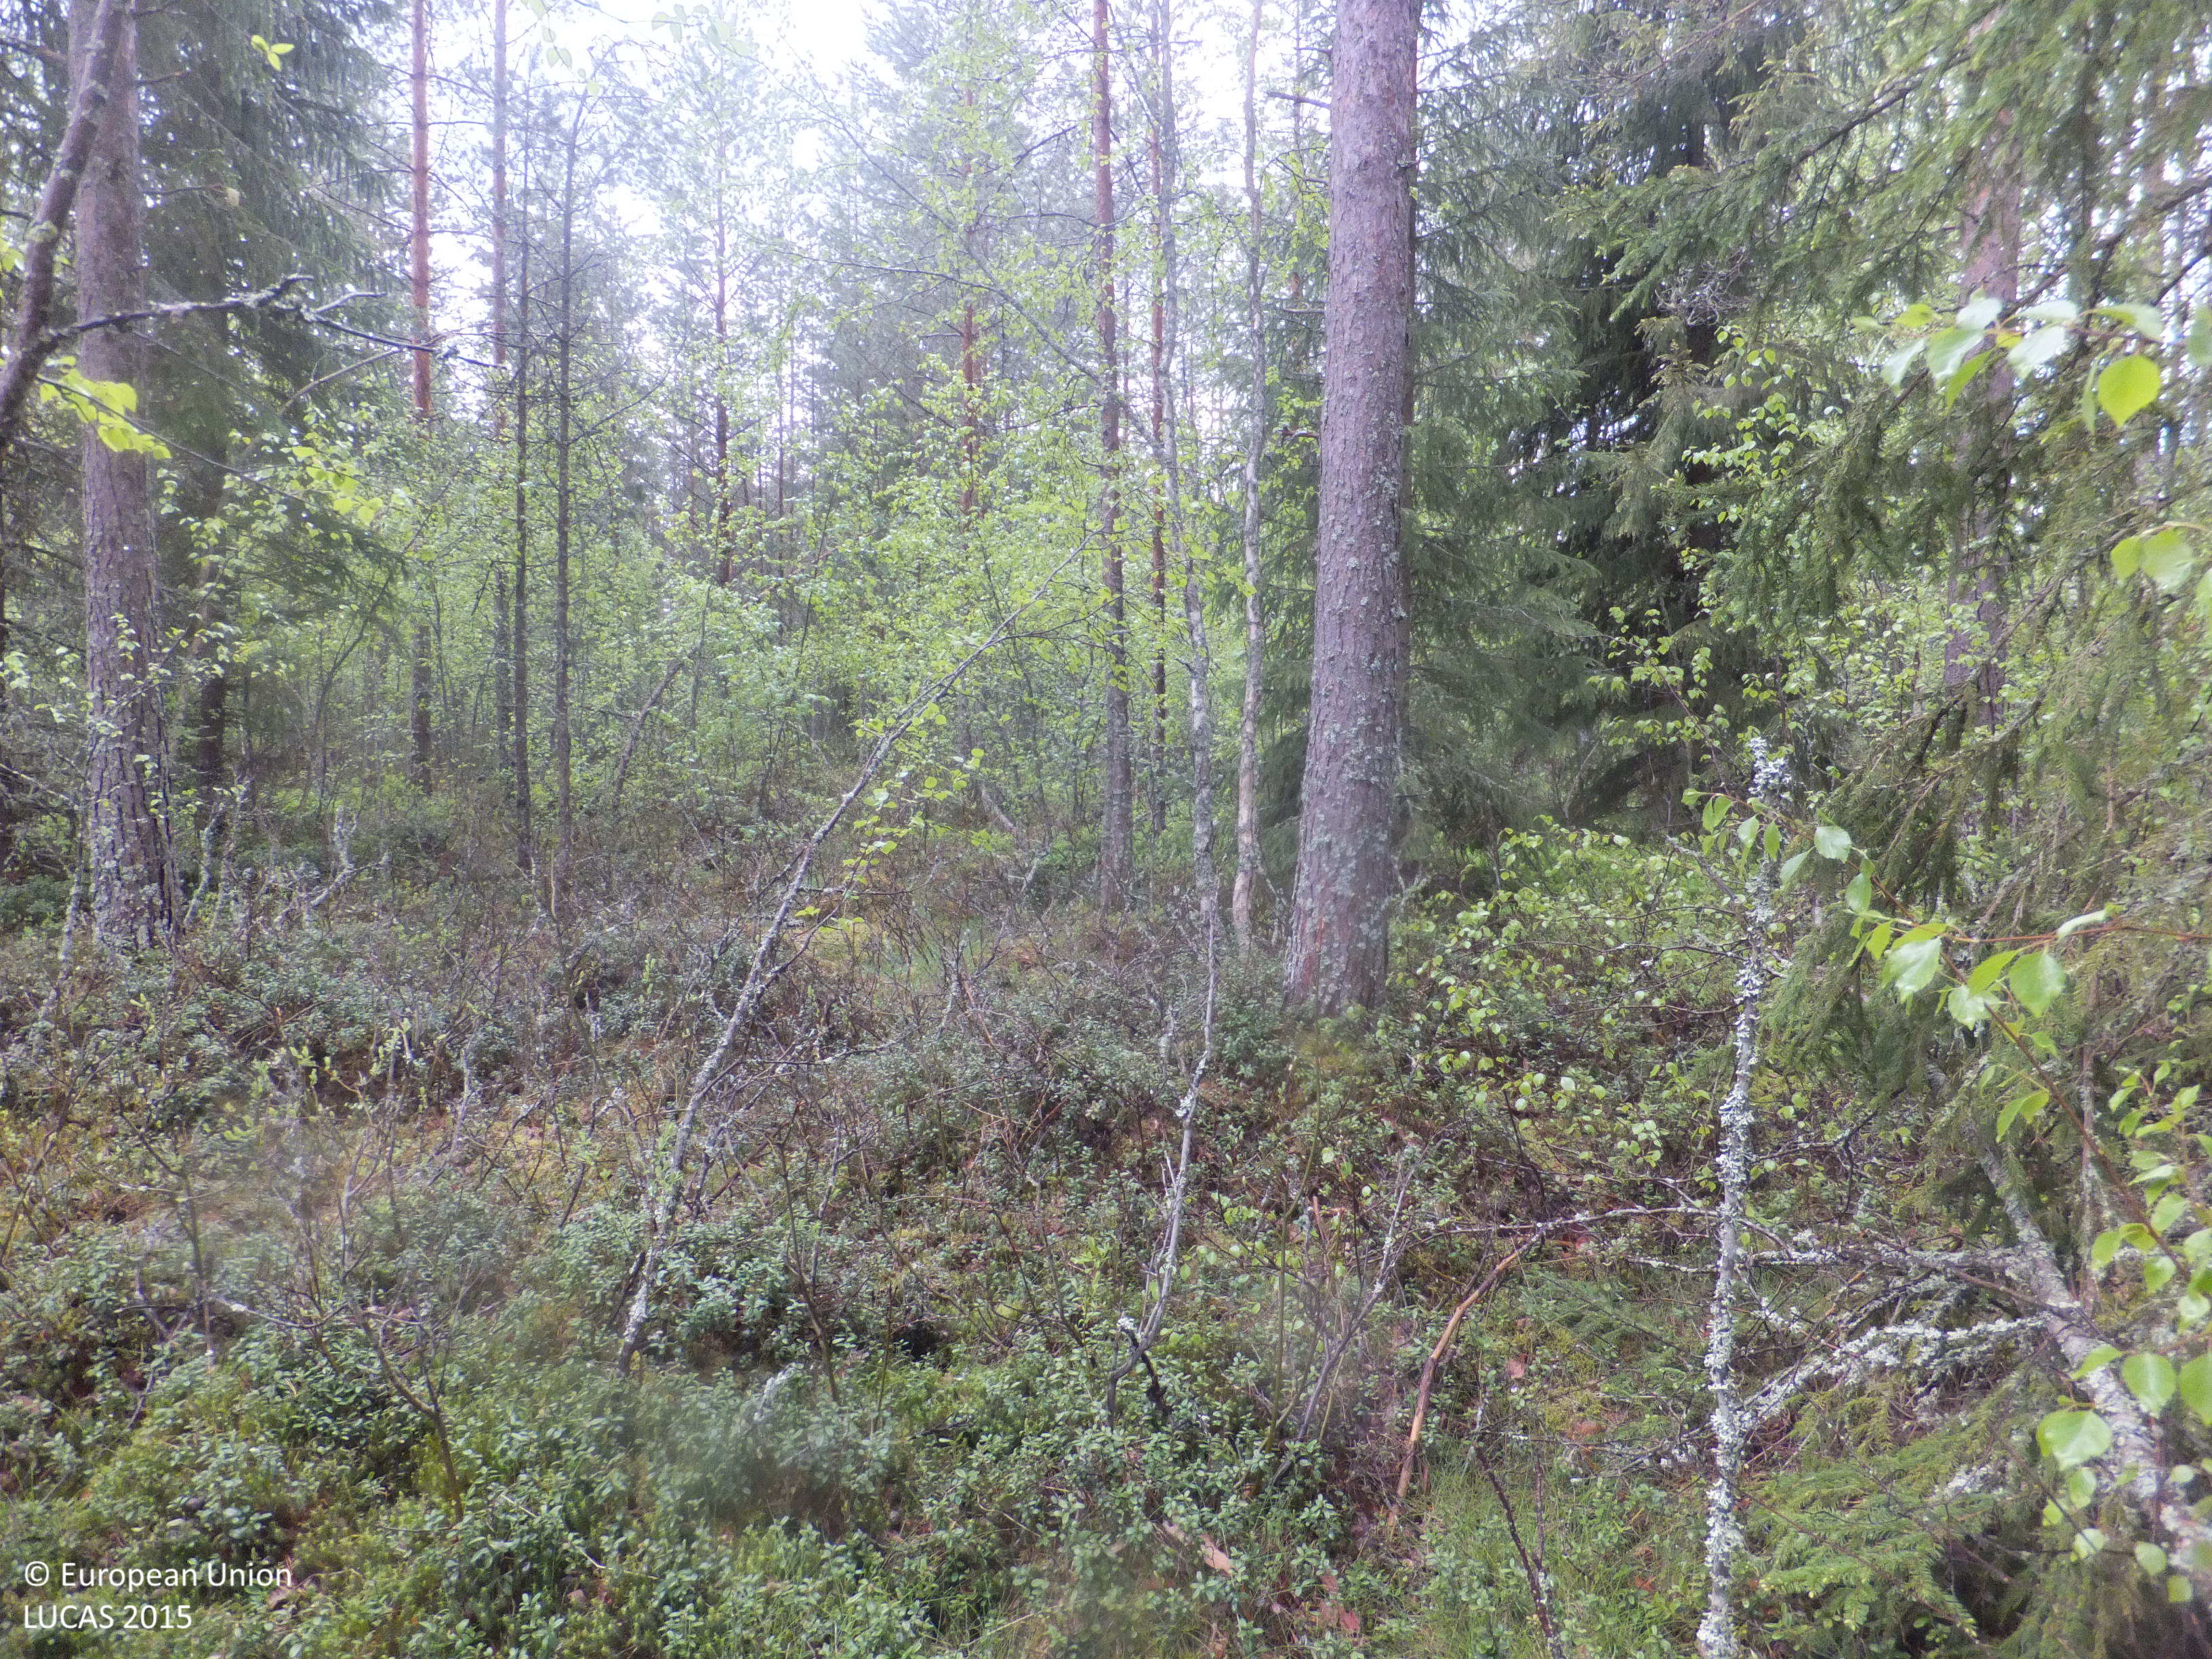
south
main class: Woodland
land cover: Pine dominated mixed woodland
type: boreal forest
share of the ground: > 75 %
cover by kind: coniferous forest trees 60 %, broadleaved forest trees 30 %, shrubs 5 %, lichens and mosses 5 %
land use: Forestry
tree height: > 5 m
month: June
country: FI
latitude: 63.3881
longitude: 23.1640
